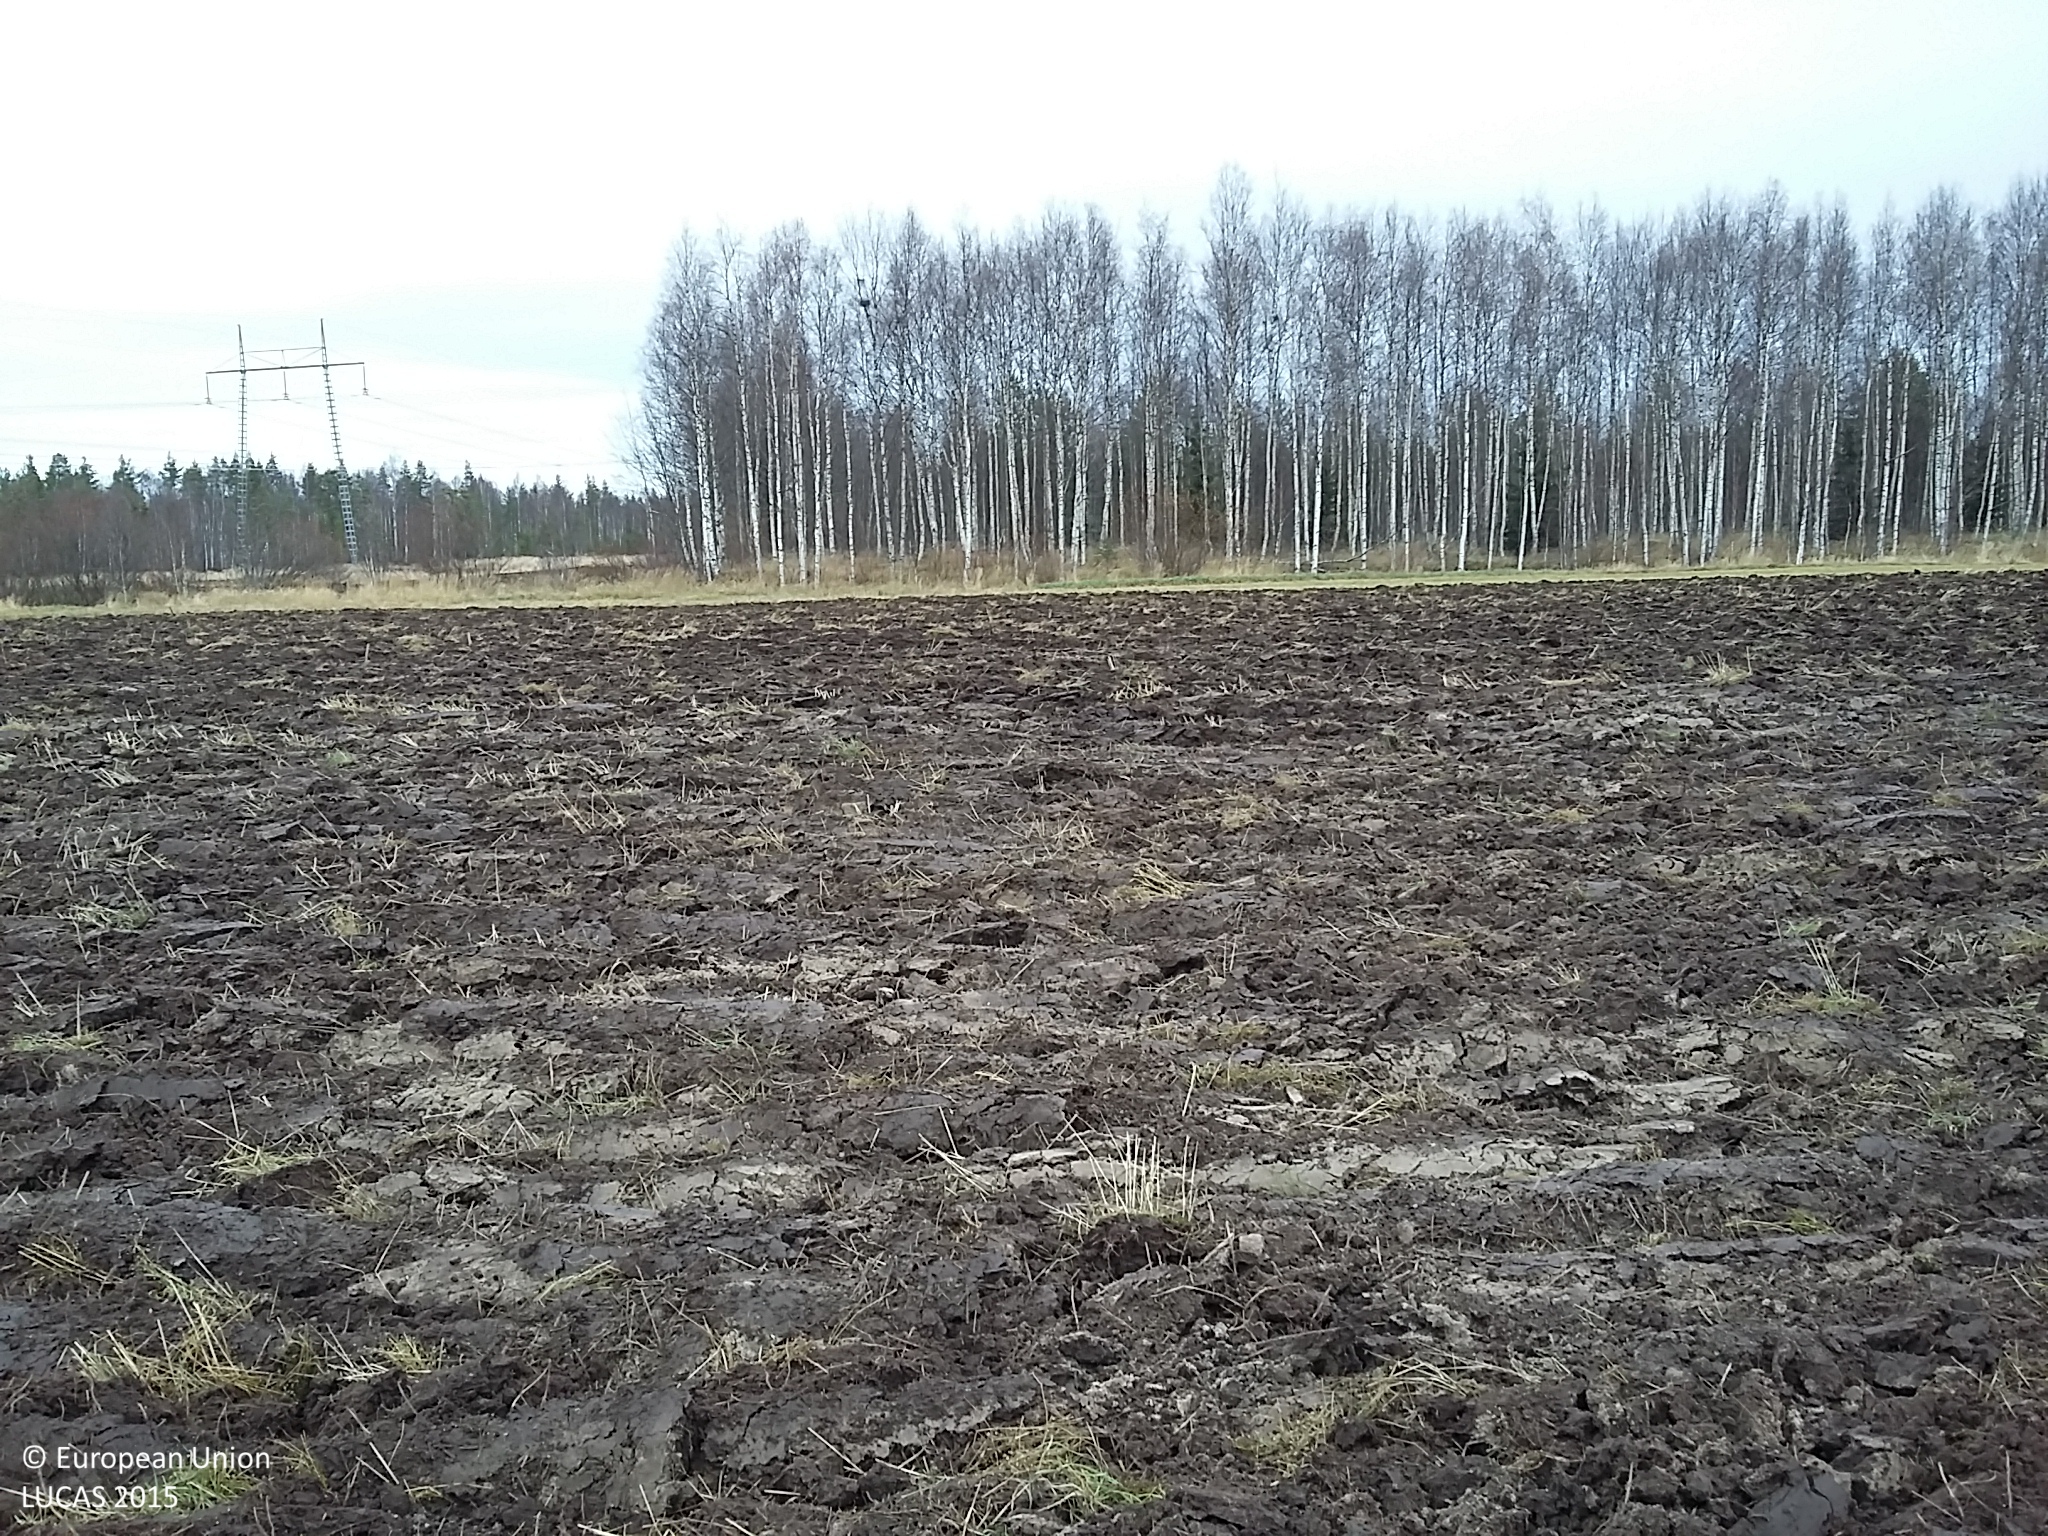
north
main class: Cropland
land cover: Oats
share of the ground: < 10 %
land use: Agriculture (excluding fallow land and kitchen gardens)
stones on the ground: < 10 %
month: October
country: FI
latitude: 64.6844
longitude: 25.4930
